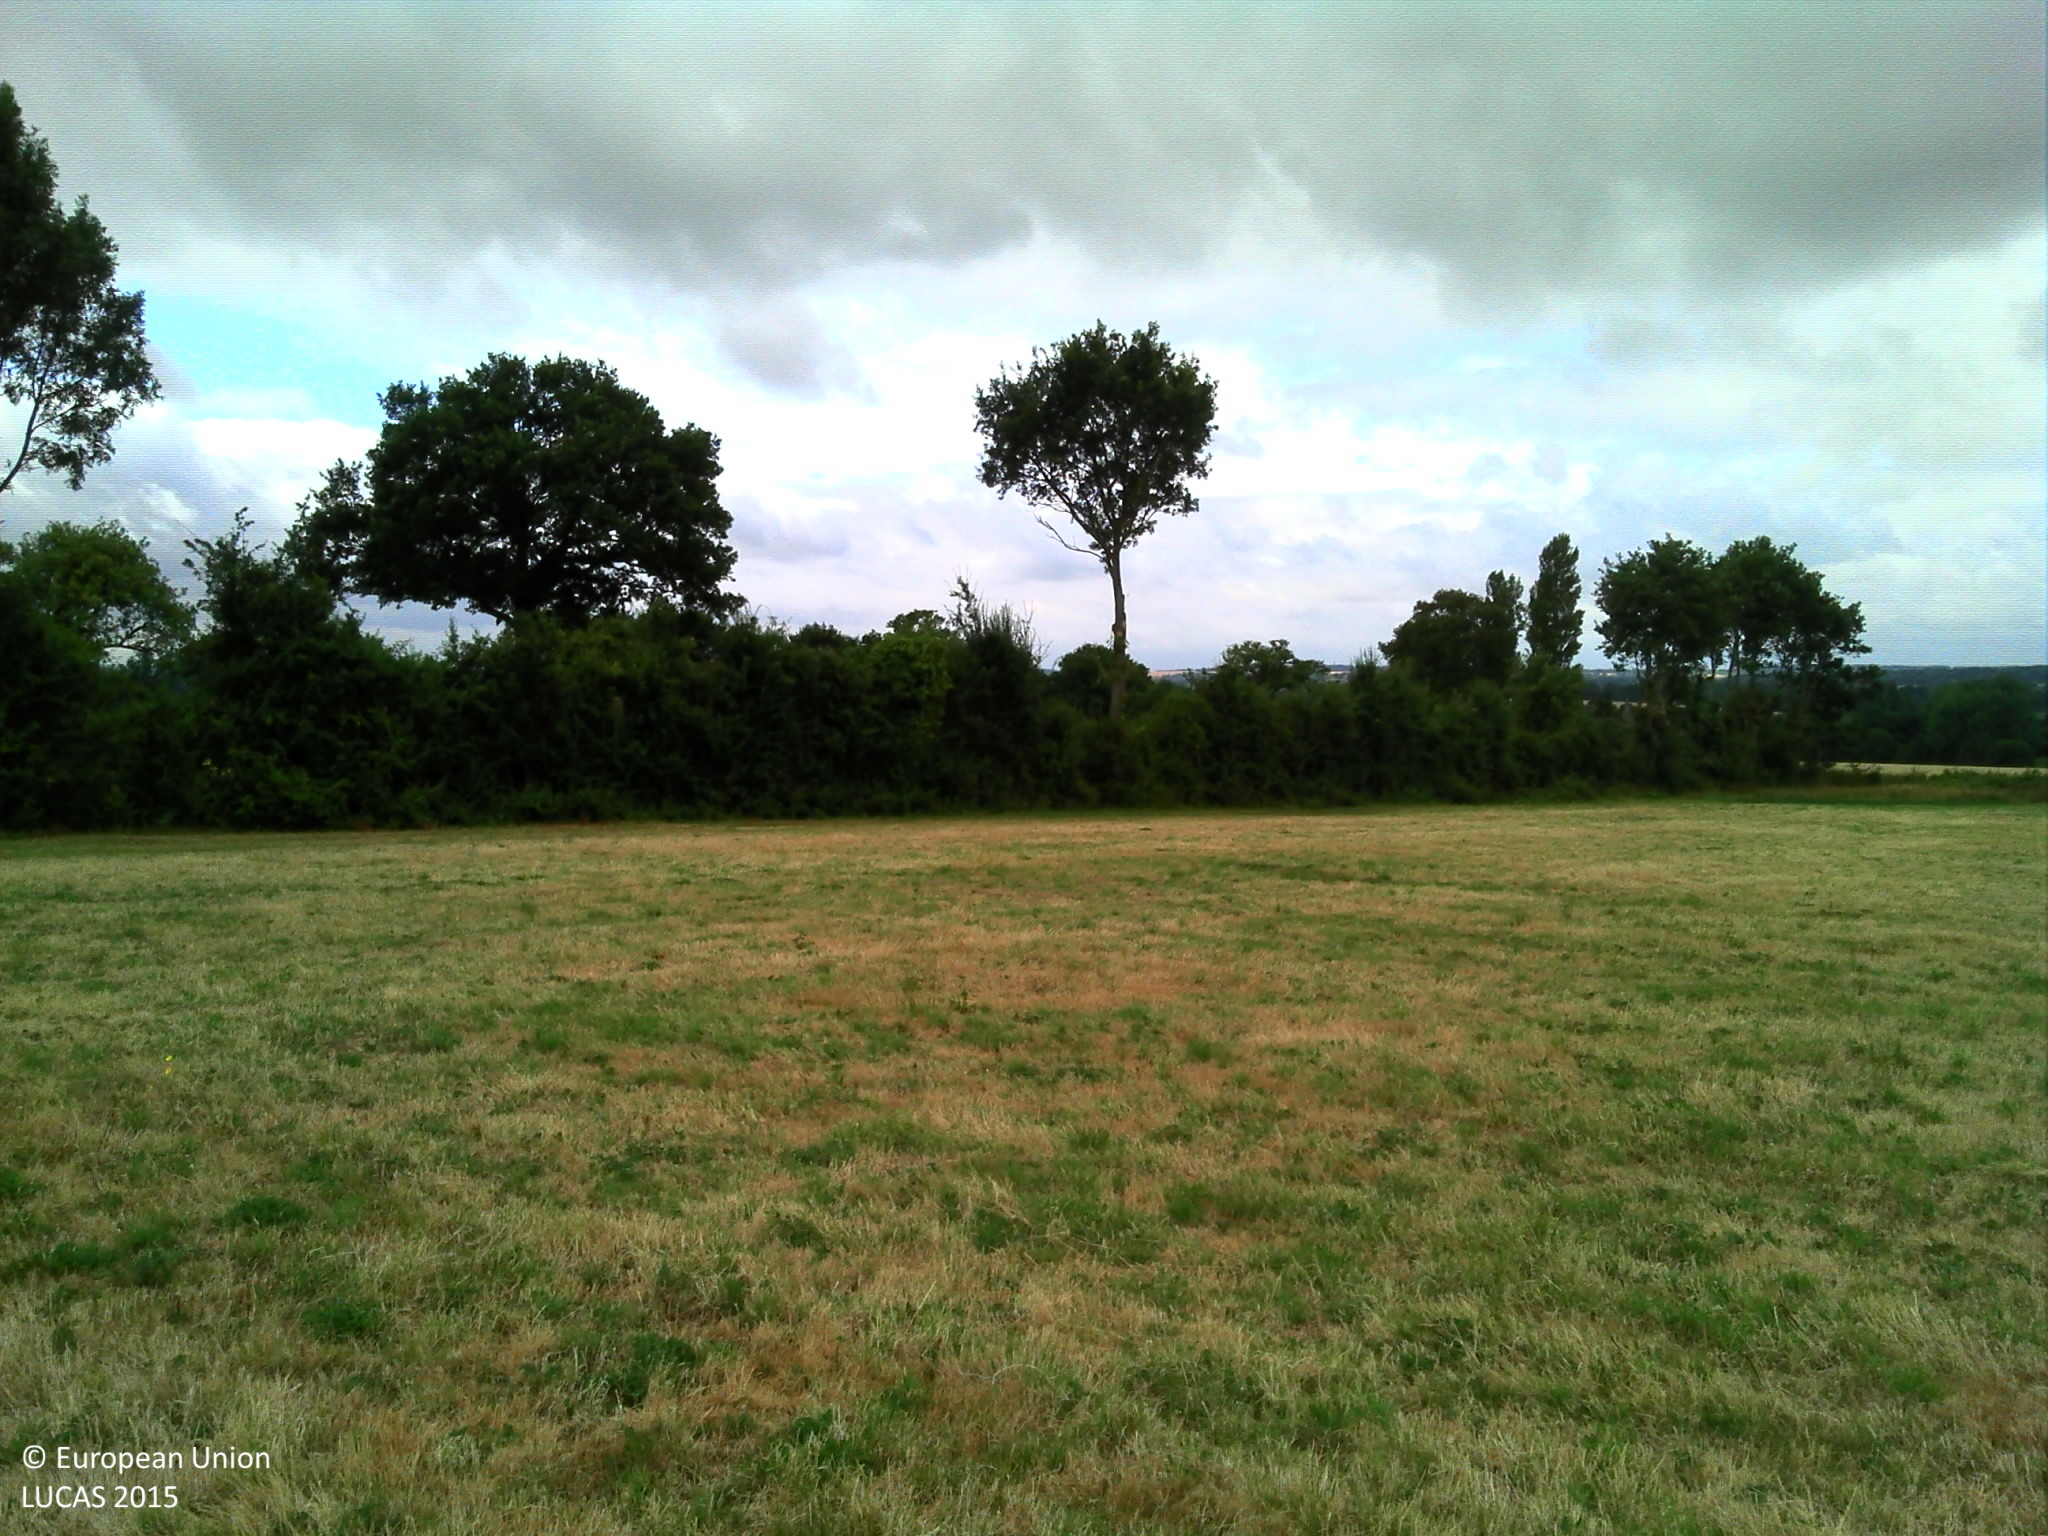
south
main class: Grassland
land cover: Grassland without tree/shrub cover
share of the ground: > 75 %
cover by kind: herbaceous plants 100 %
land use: Agriculture (excluding fallow land and kitchen gardens)
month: July
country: FR
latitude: 48.4270
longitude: -0.1258
